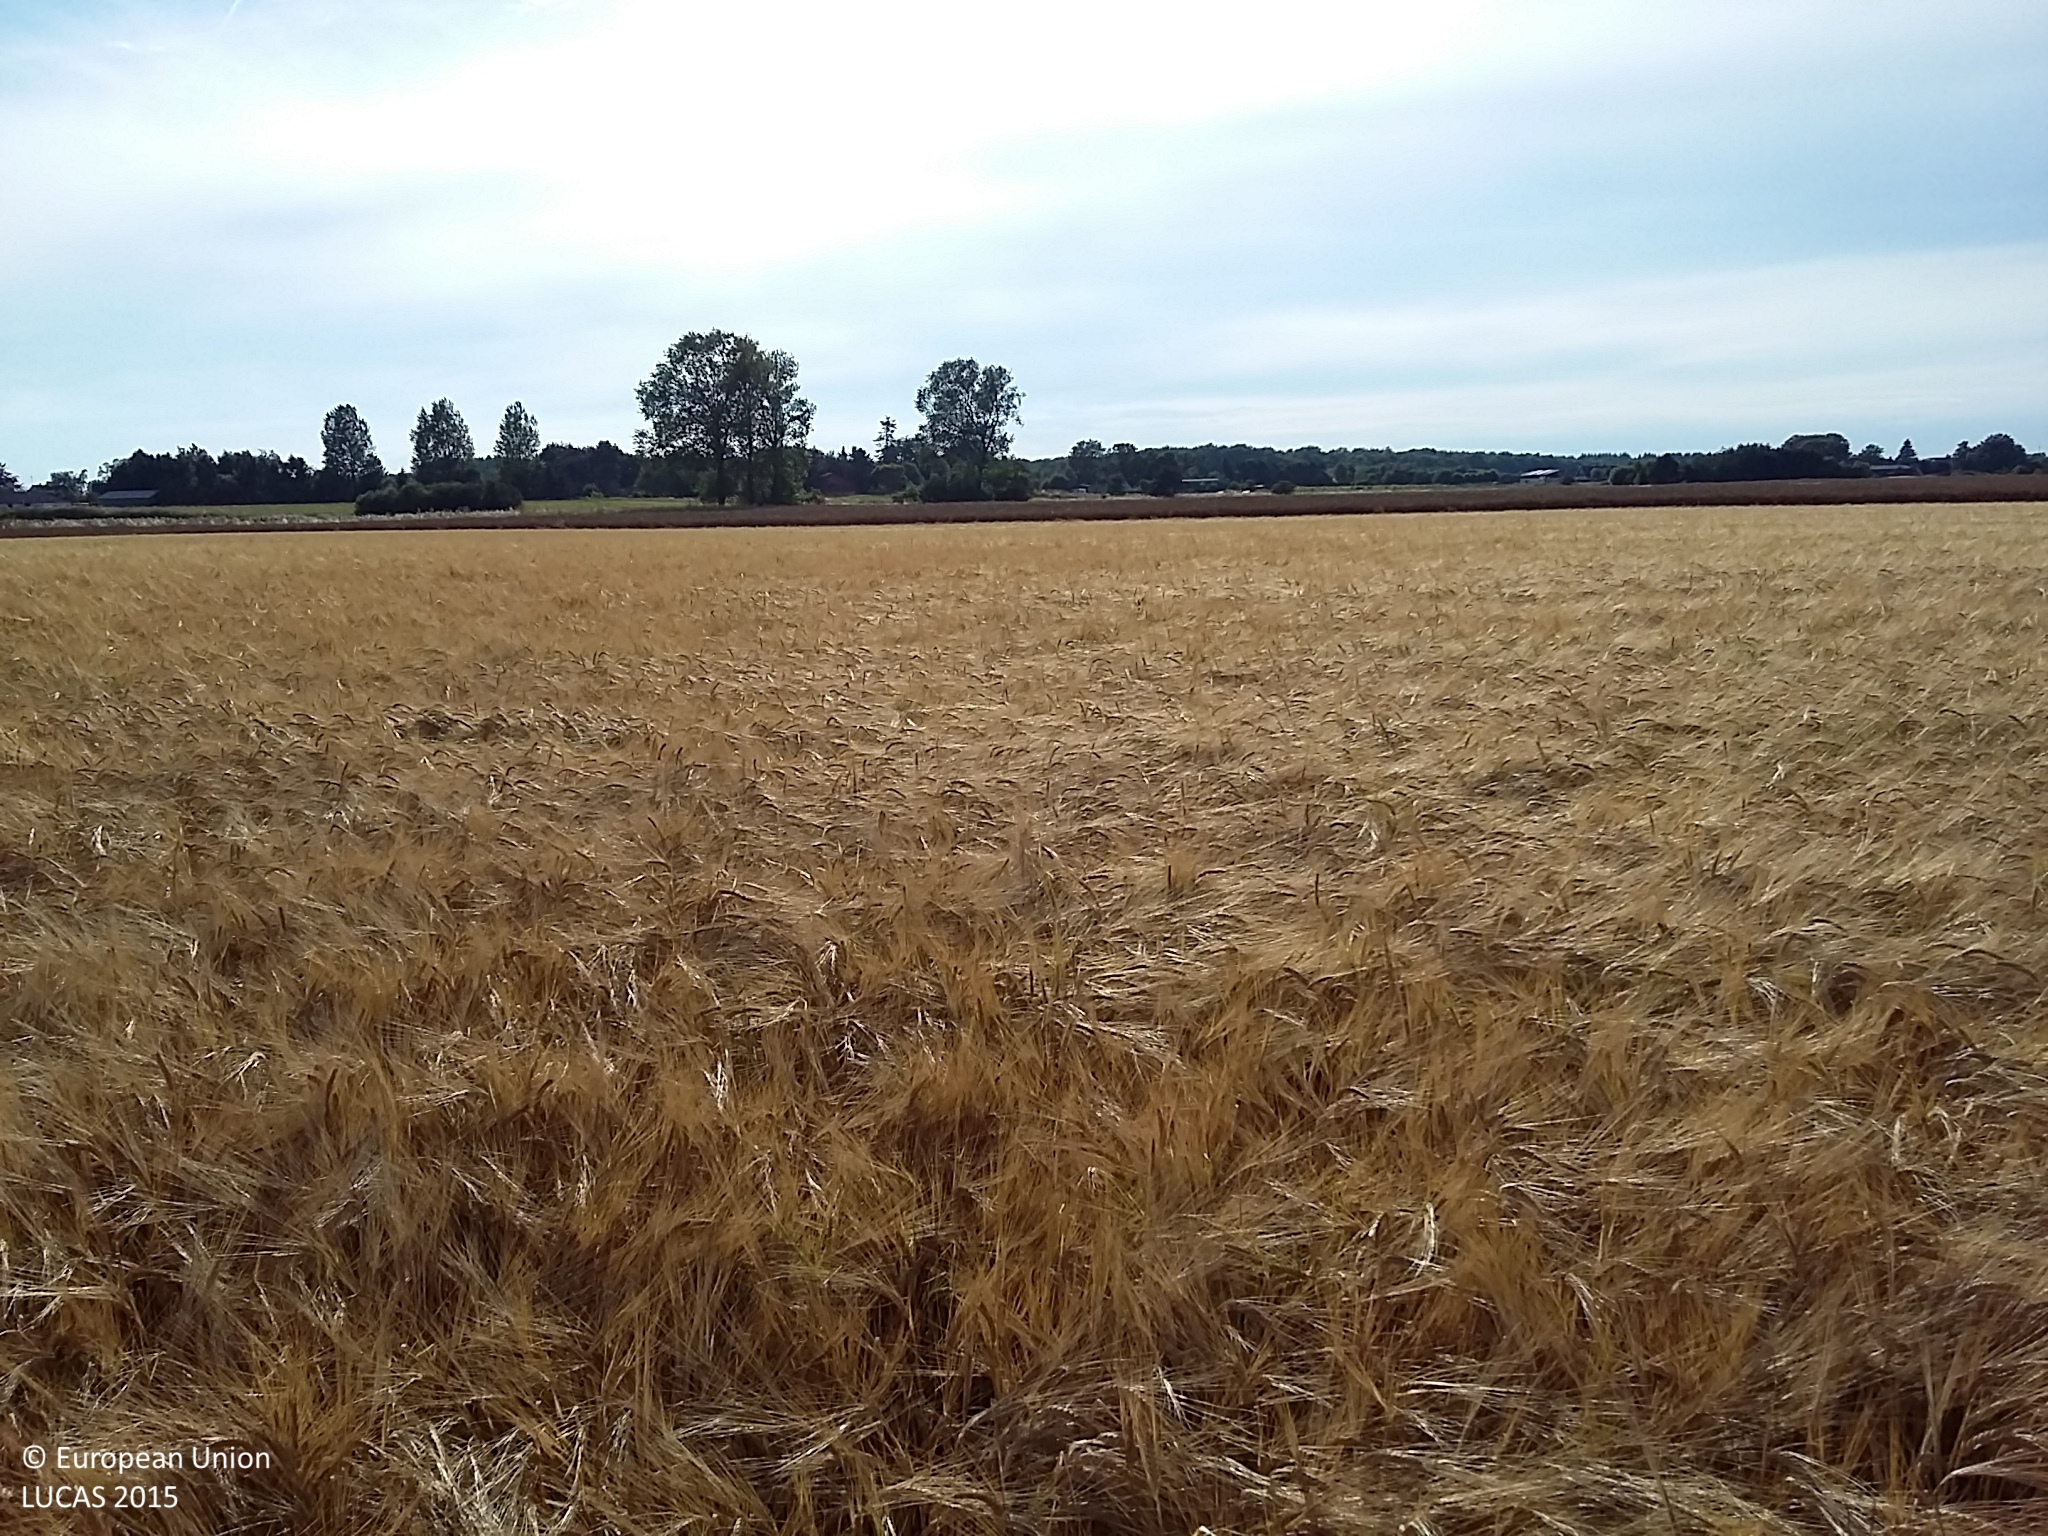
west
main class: Cropland
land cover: Barley
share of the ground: > 75 %
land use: Agriculture (excluding fallow land and kitchen gardens)
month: August
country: DK
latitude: 55.5242
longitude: 12.0417
